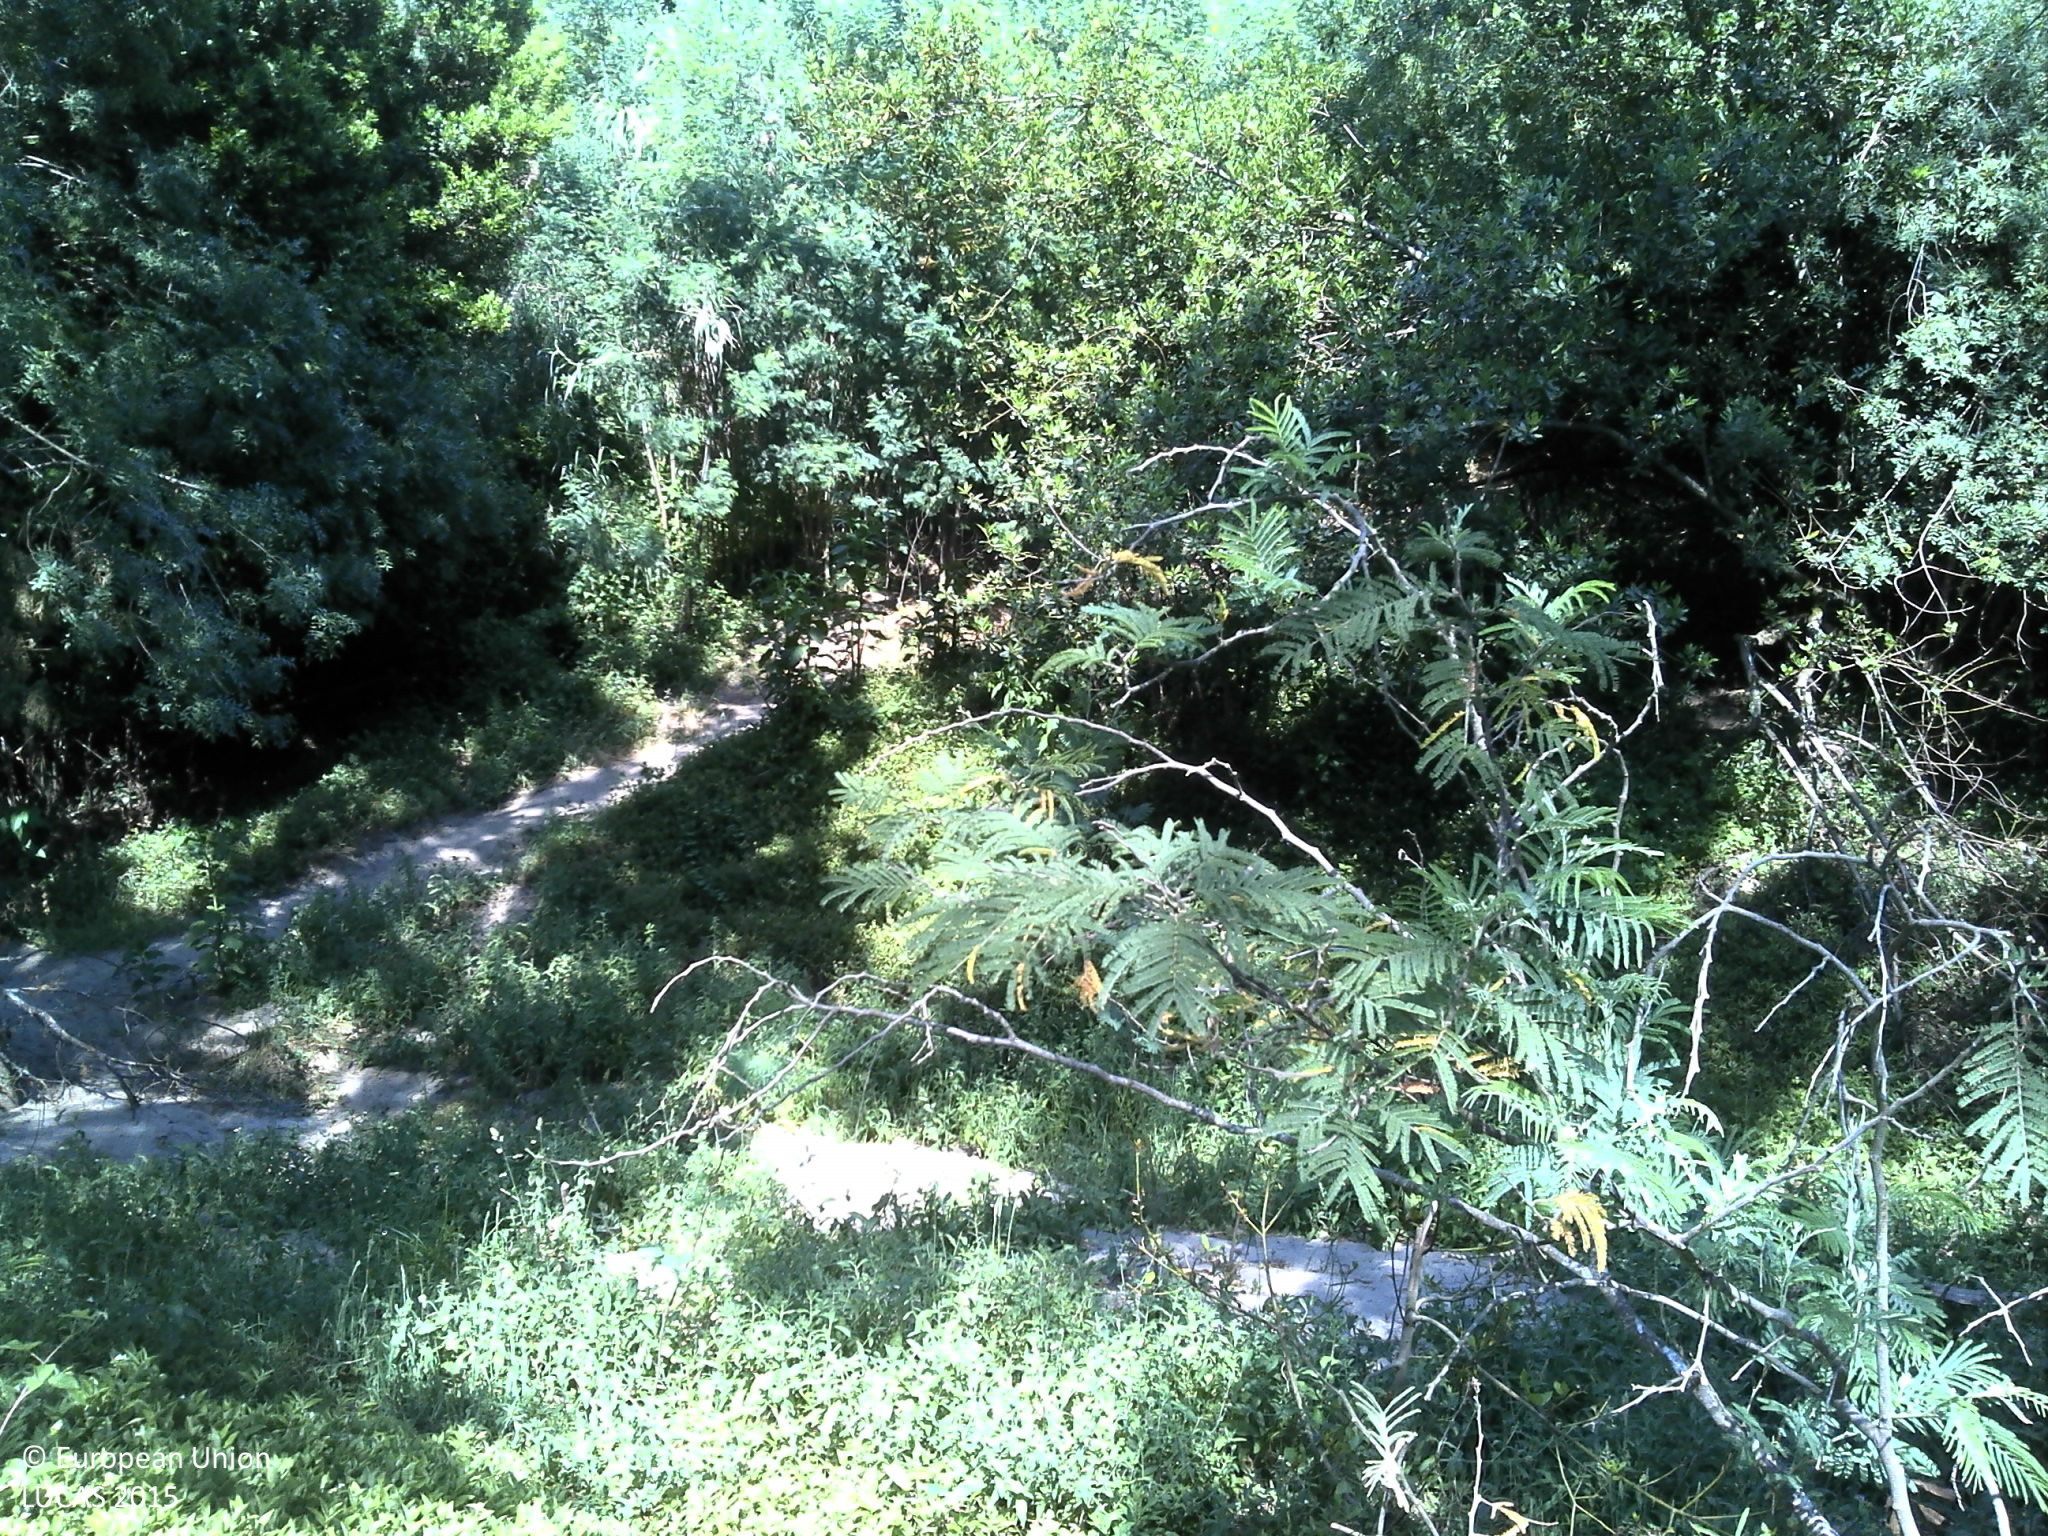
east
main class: Woodland
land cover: Broadleaved woodland
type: floodplain forest
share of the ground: > 75 %
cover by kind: broadleaved forest trees 70 %, unconsolidated bare surface 15 %, herbaceous plants 10 %, shrubs 5 %
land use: Semi-natural and natural areas not in use
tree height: > 5 m
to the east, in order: Broadleaved woodland; Tracks; Broadleaved woodland; Dry stone walls; Broadleaved woodland; Dry stone walls; Paved roads, cycling and walking lanes; Dry stone walls; Broadleaved woodland; Tracks; Electric lines; Shrubland without tree cover; Artificial constructions in urban areas
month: June
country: PT
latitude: 42.1519
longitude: -8.2003
